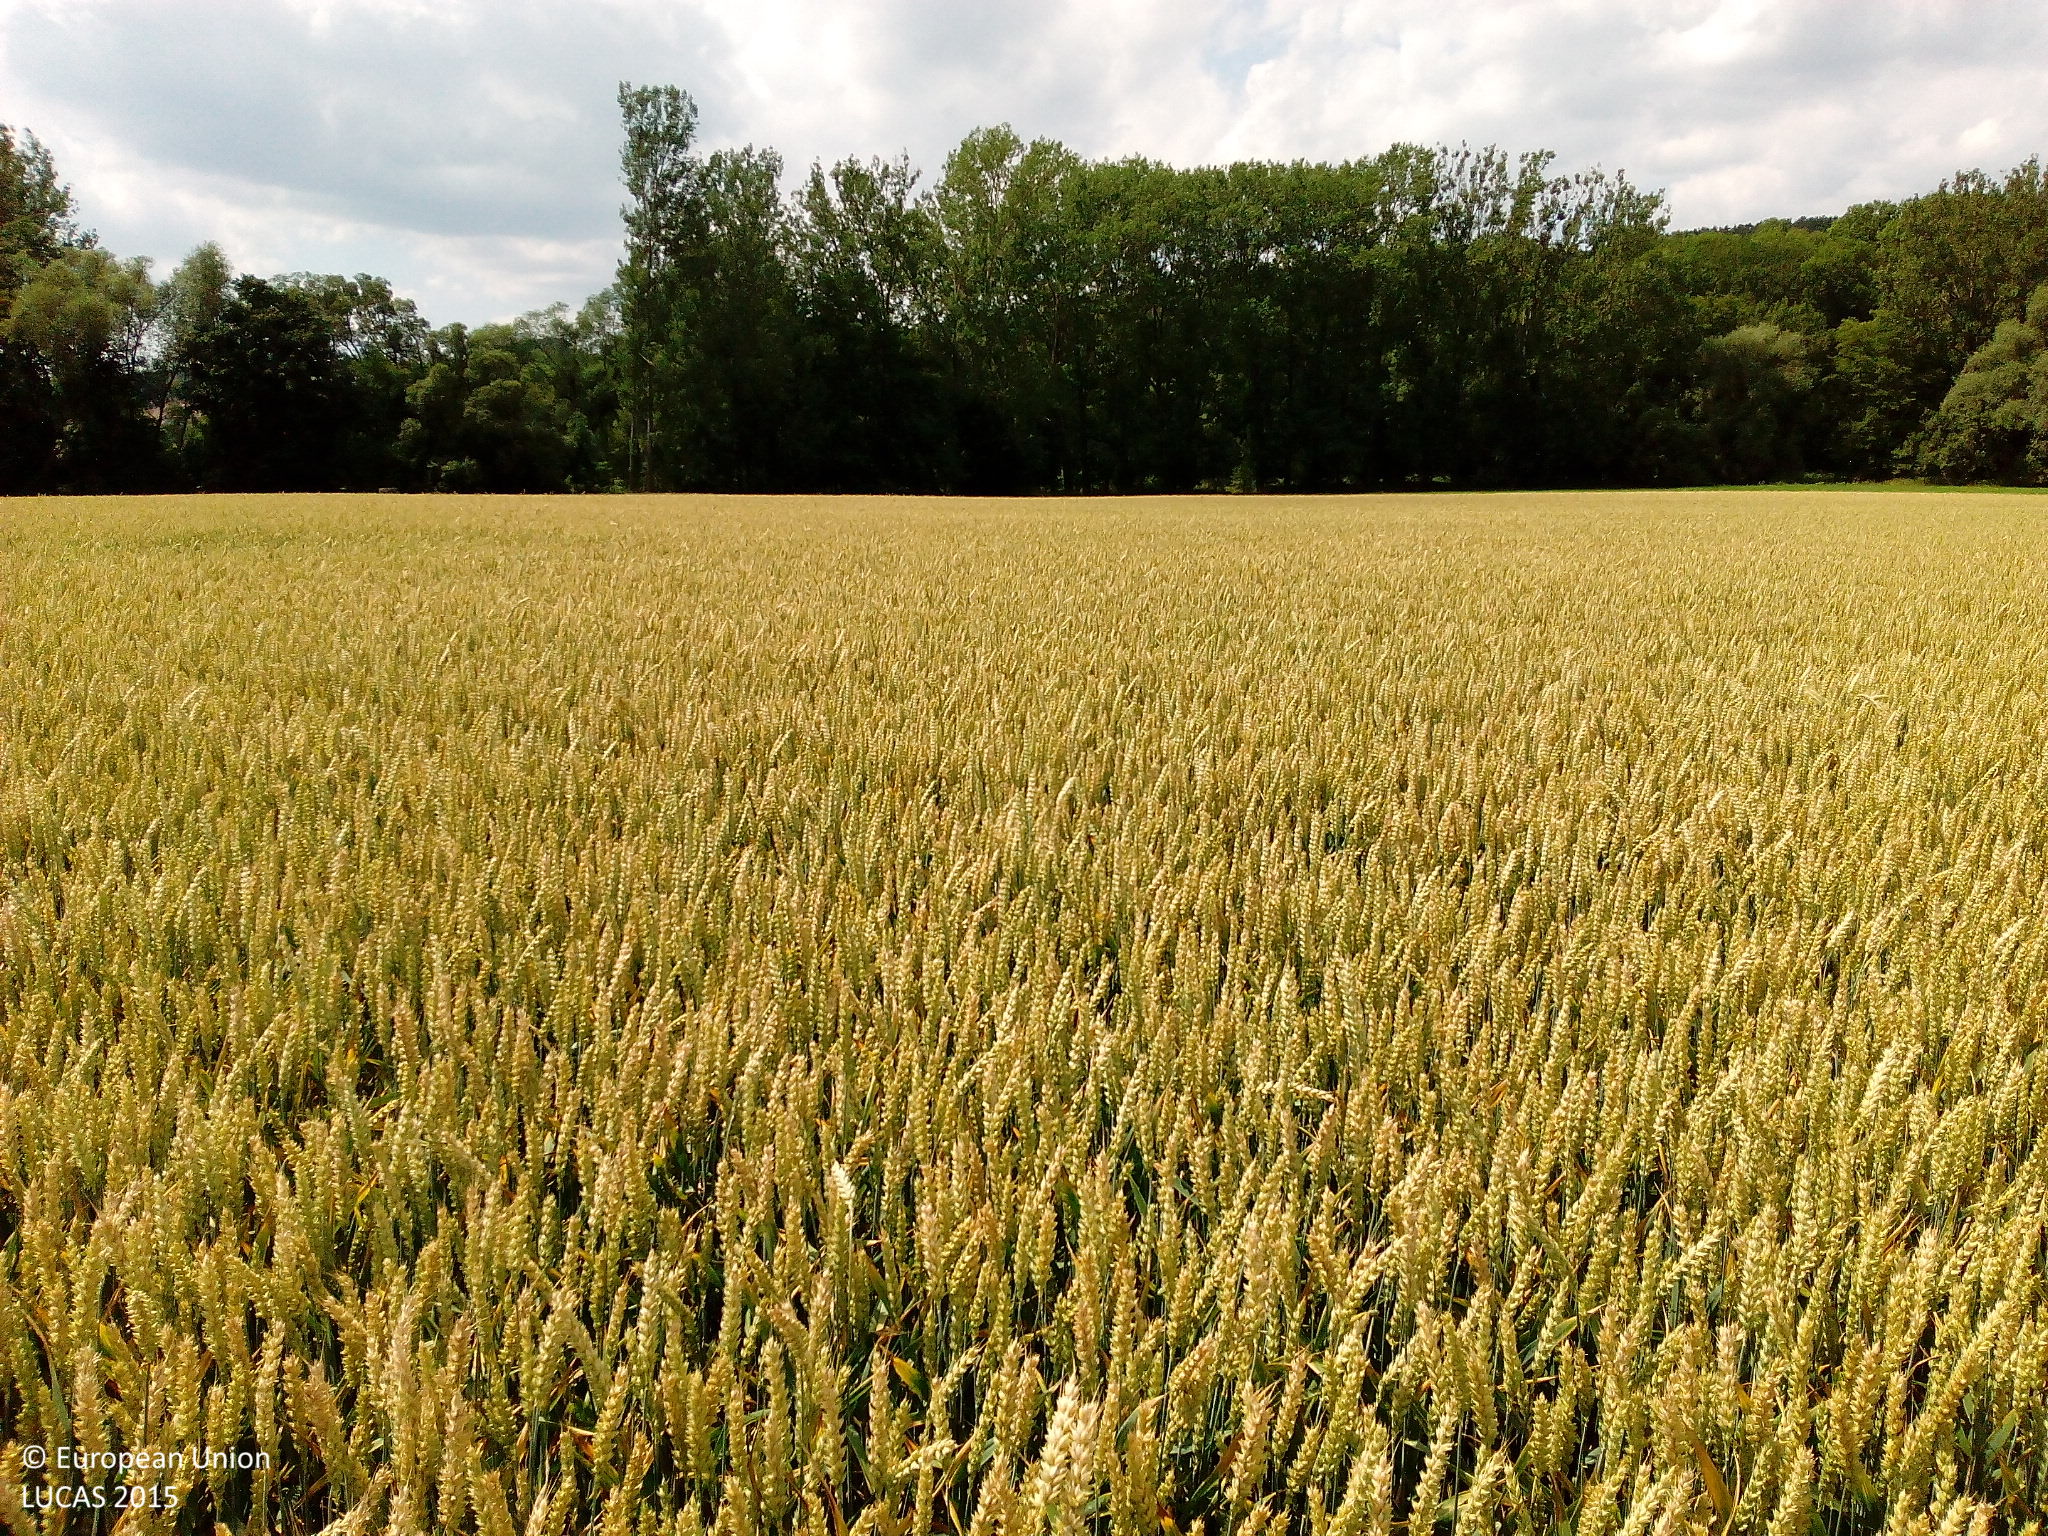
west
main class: Cropland
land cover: Common wheat
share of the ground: > 75 %
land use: Agriculture (excluding fallow land and kitchen gardens)
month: July
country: DE
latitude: 50.7236
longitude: 9.9575
